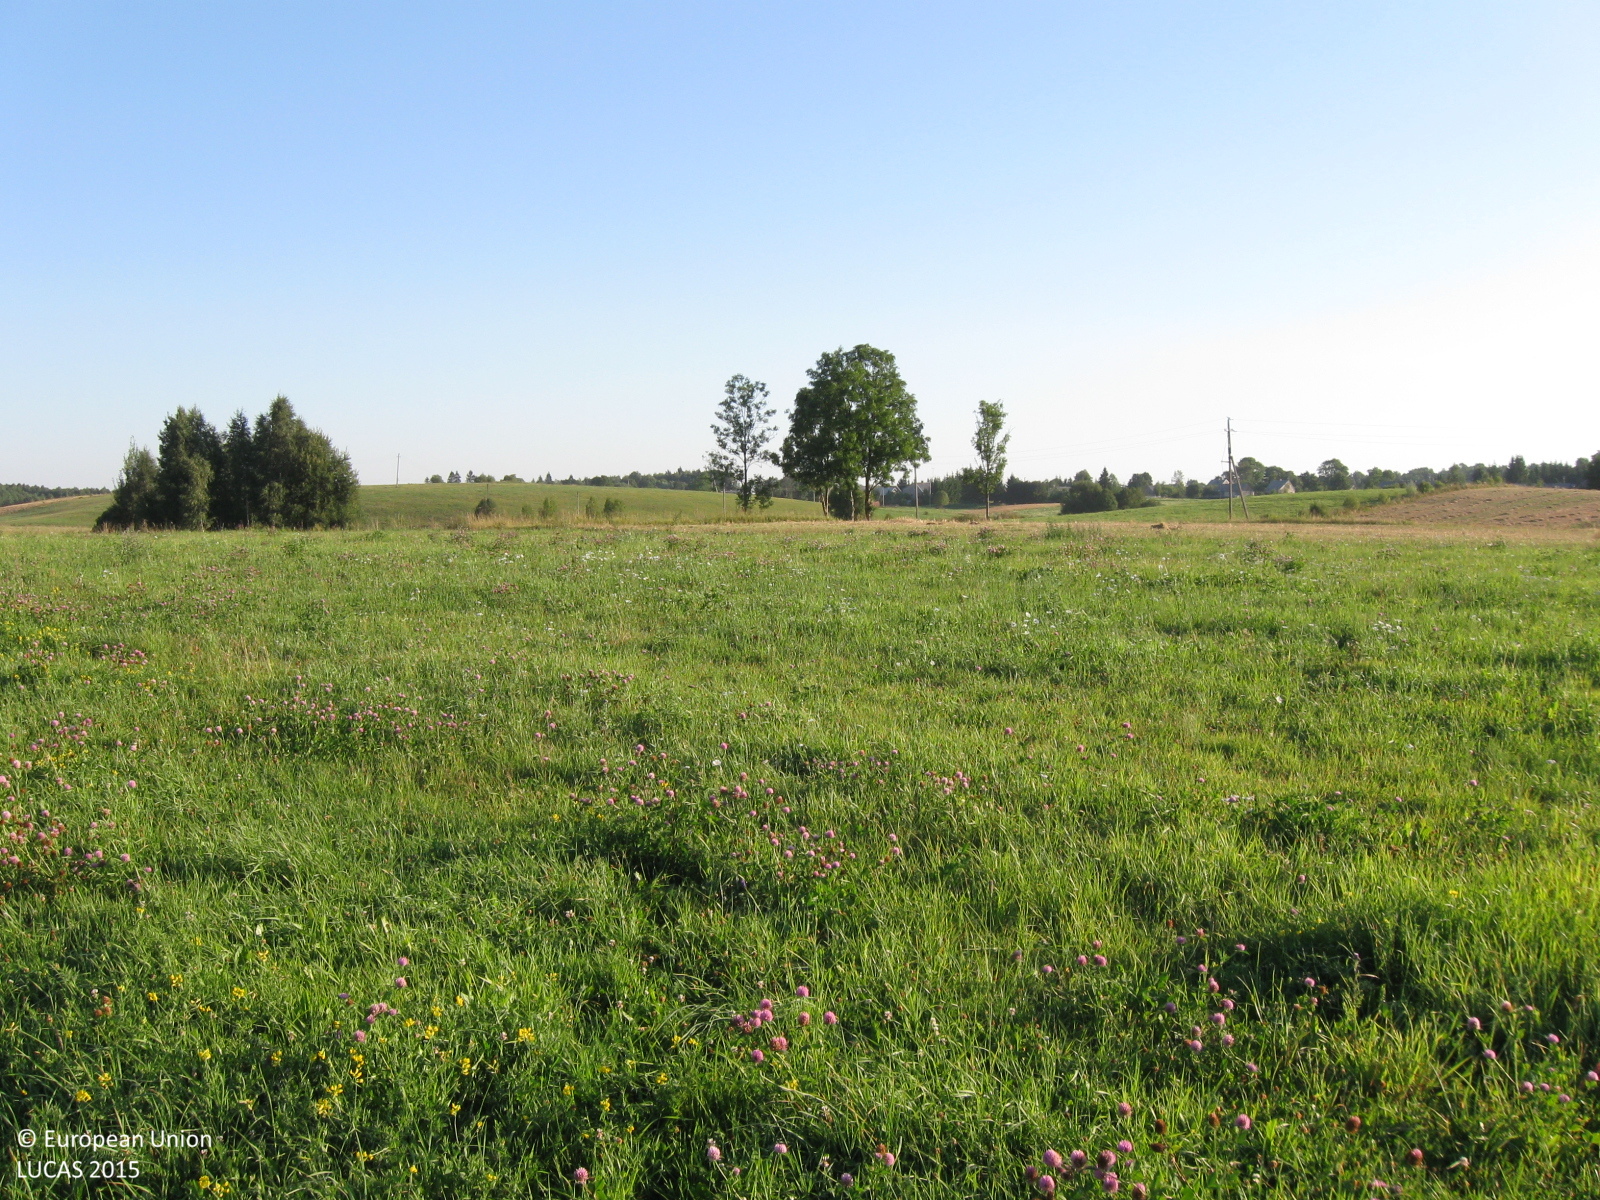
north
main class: Cropland
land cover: Other leguminous and mixtures for fodder
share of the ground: > 75 %
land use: Agriculture (excluding fallow land and kitchen gardens)
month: August
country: LT
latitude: 55.4634
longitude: 22.5085
